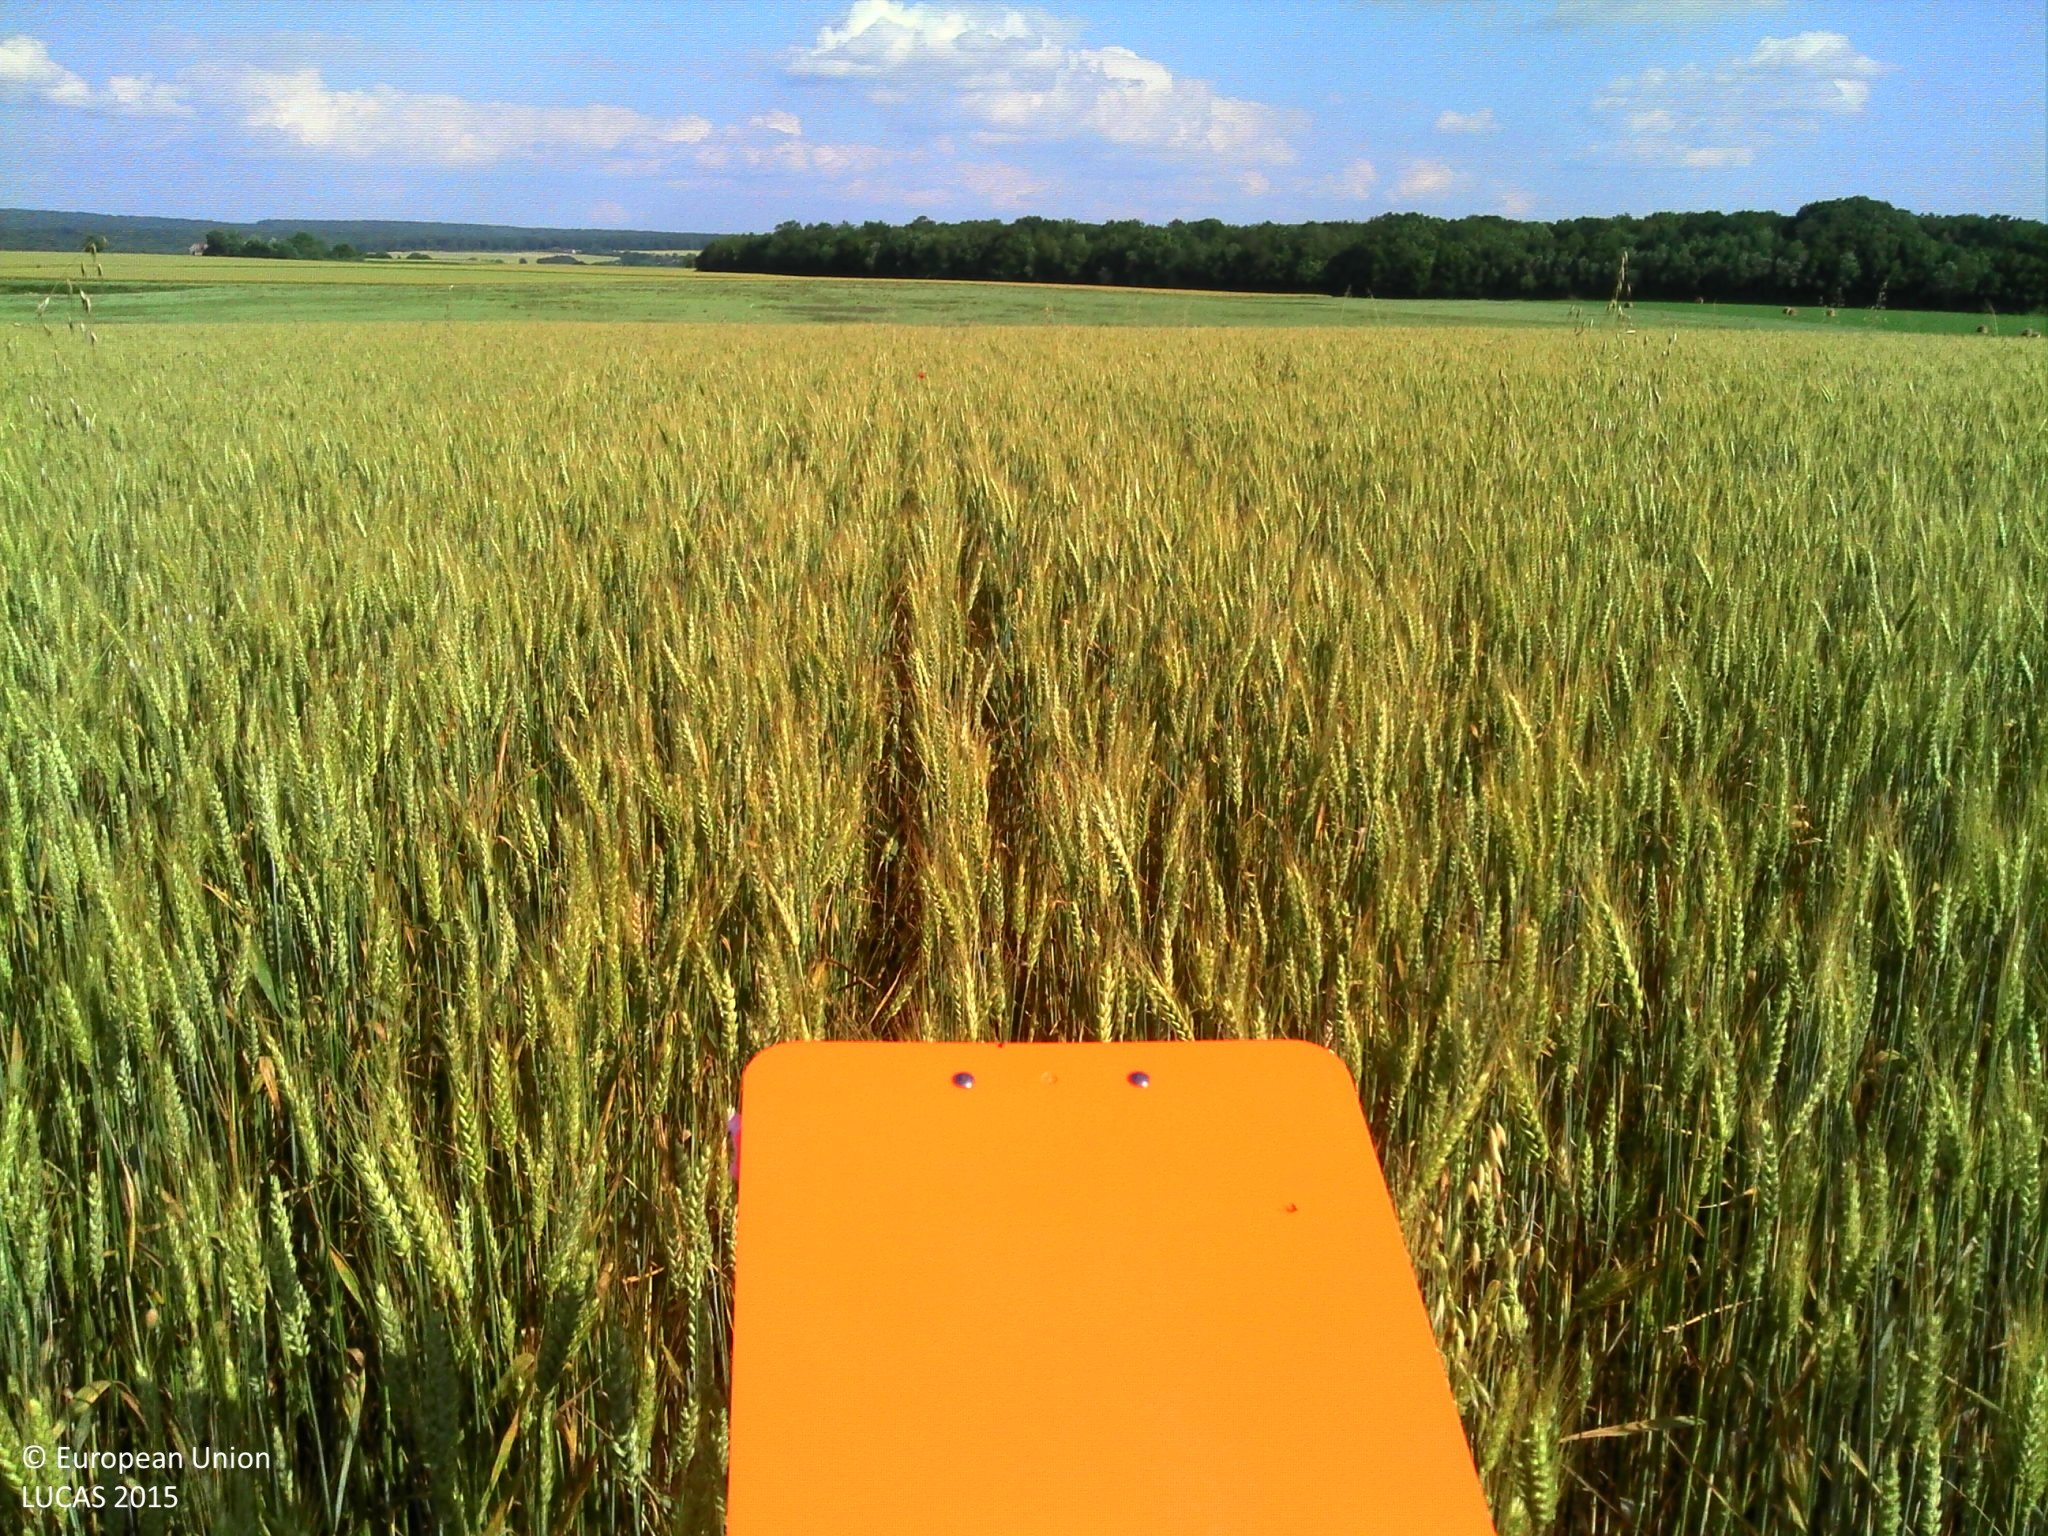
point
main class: Cropland
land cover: Common wheat
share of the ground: > 75 %
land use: Agriculture (excluding fallow land and kitchen gardens)
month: June
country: FR
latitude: 47.4173
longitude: 3.1957
